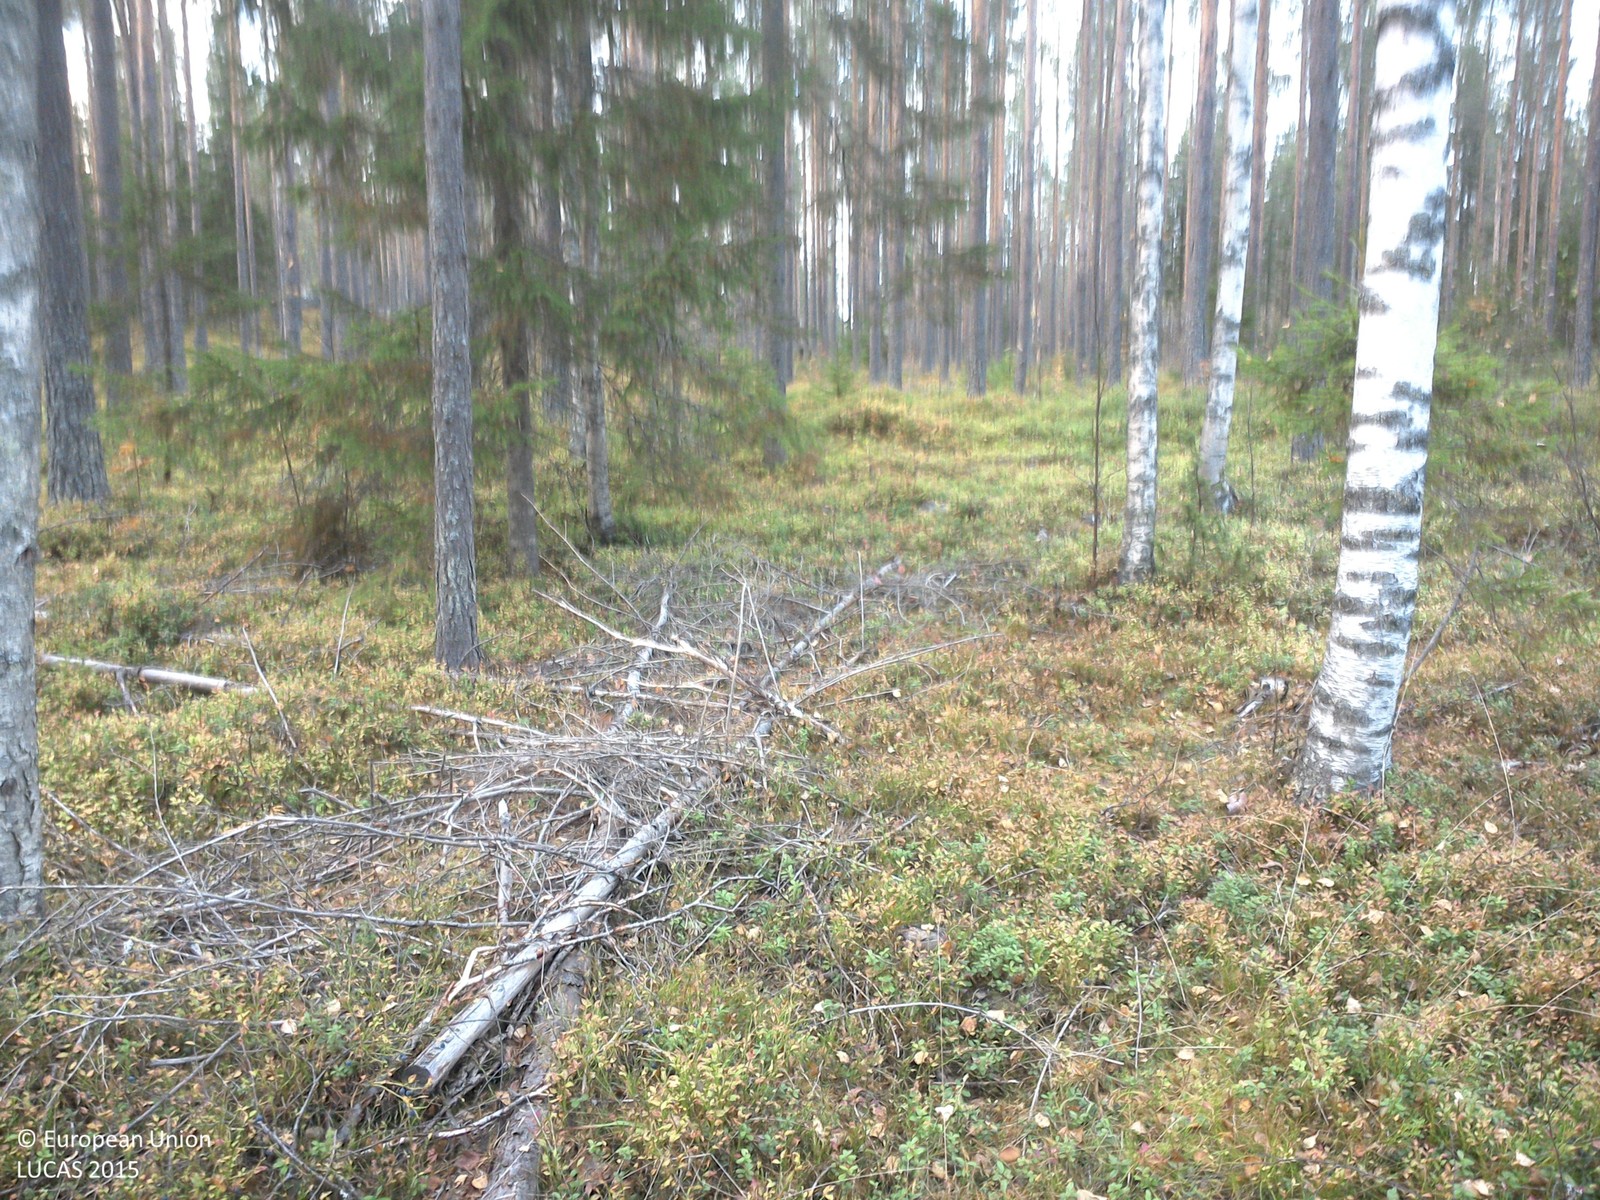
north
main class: Woodland
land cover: Pine dominated mixed woodland
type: boreal forest
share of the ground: 25 - 50 %
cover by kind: shrubs 50 %, coniferous forest trees 30 %, broadleaved forest trees 20 %
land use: Forestry
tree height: > 5 m
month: October
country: SE
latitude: 63.8676
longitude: 19.9304
